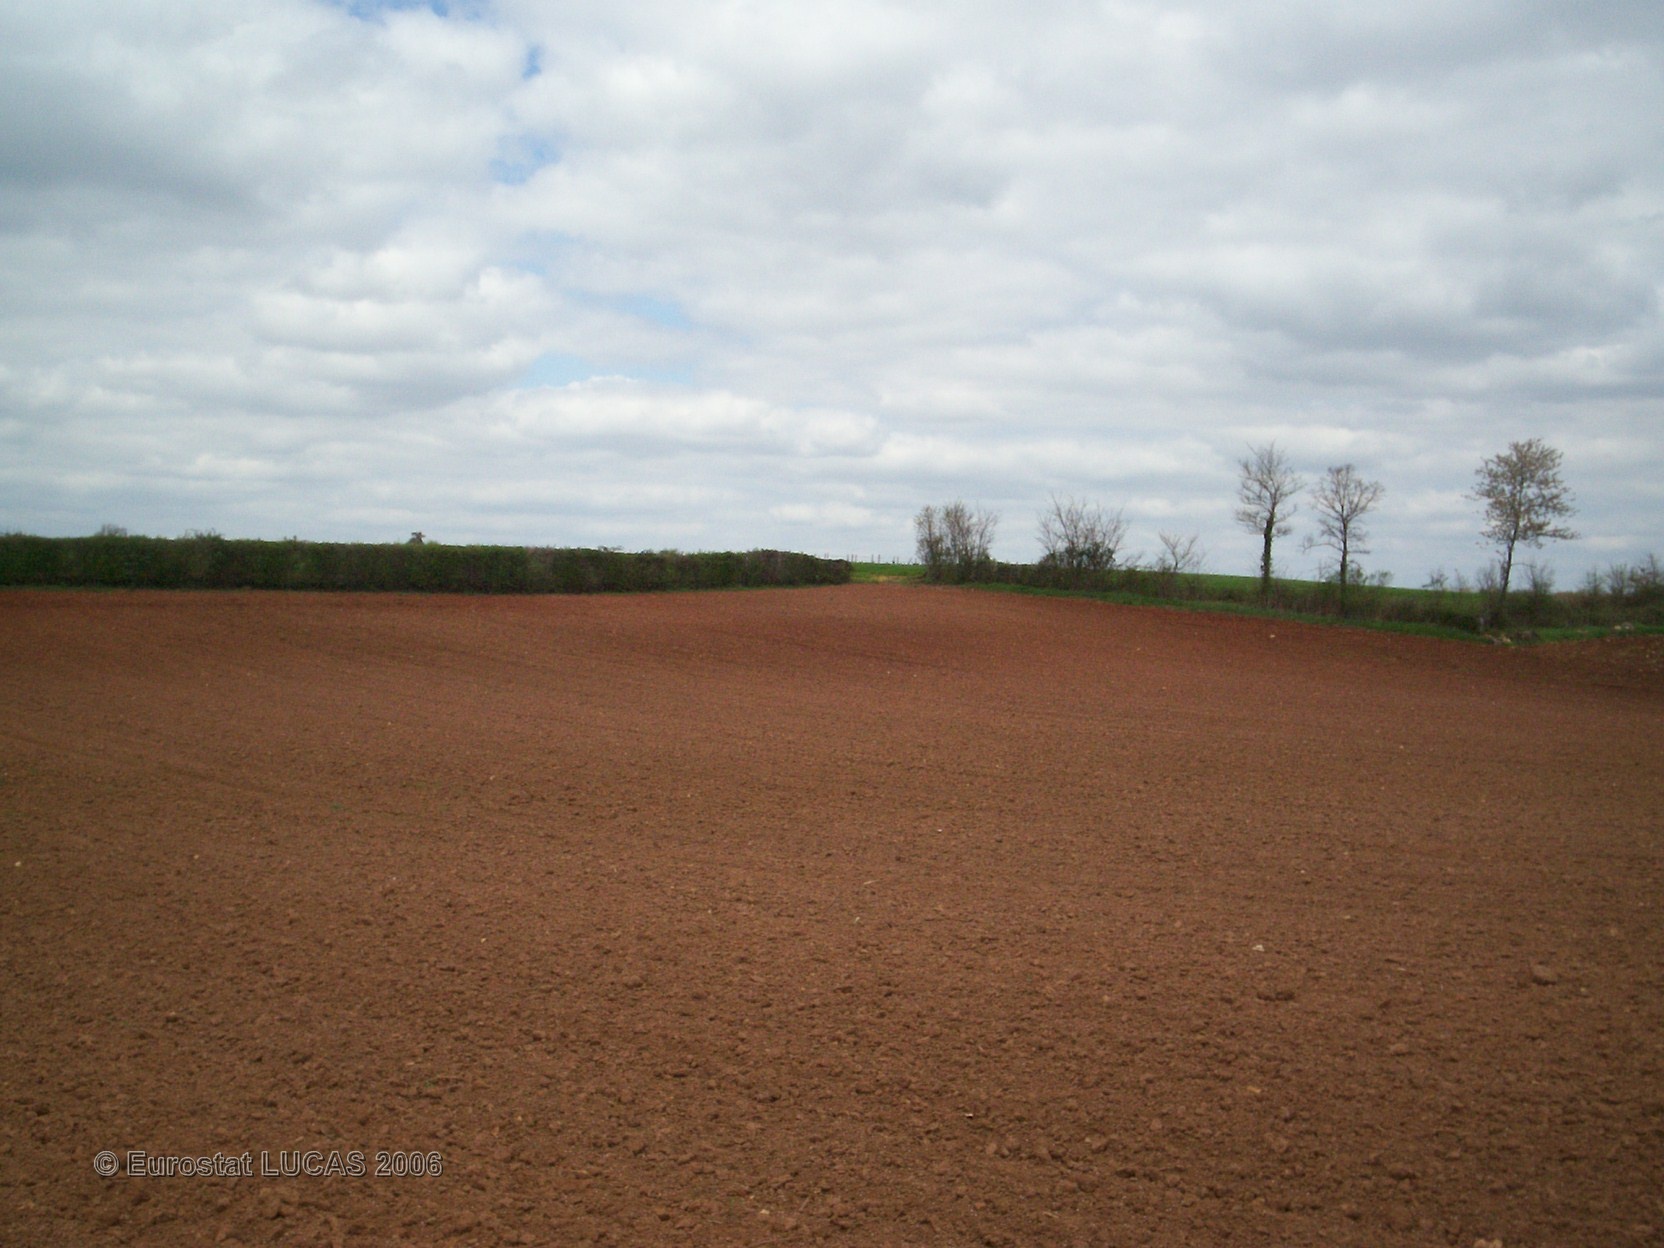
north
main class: Cropland
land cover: Sunflower
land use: Agriculture (excluding fallow land and kitchen gardens)
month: May
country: FR
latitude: 46.2027
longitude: 0.5364
